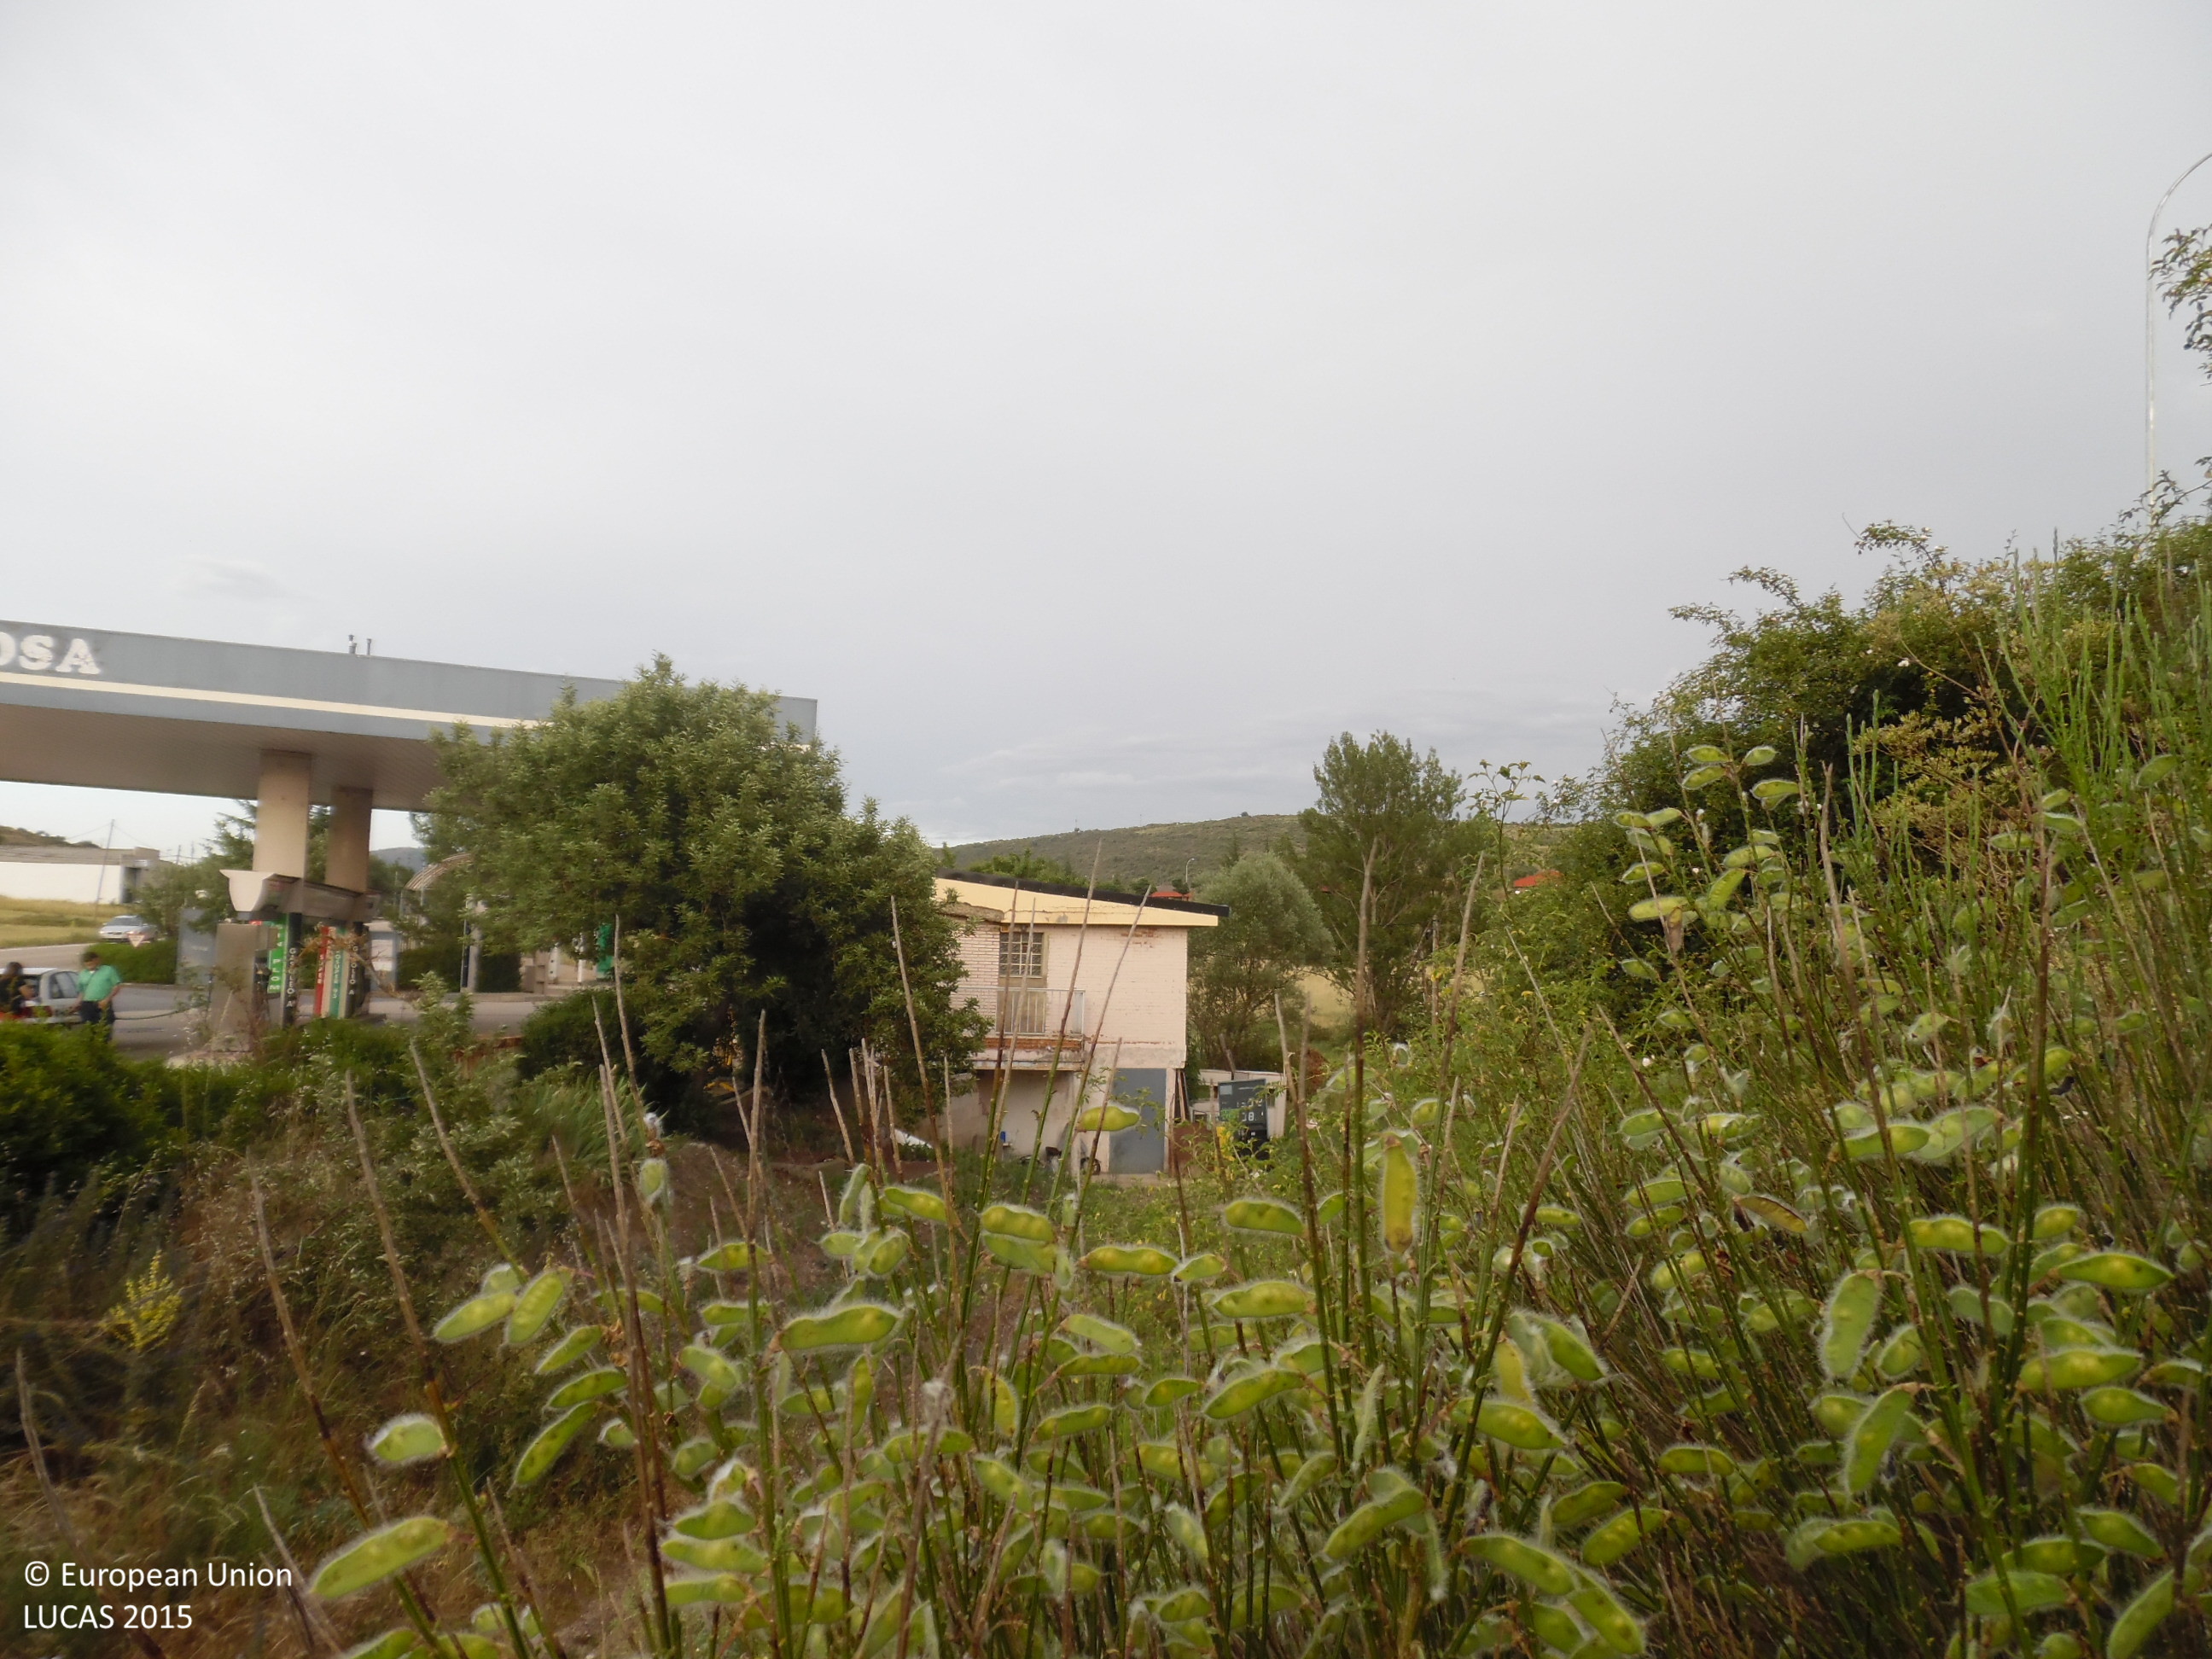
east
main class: Grassland
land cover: Grassland with sparse tree/shrub cover
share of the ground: 10 - 25 %
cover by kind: unconsolidated bare surface 70 %, herbaceous plants 25 %, broadleaved forest trees 5 %
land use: Road transport
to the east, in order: Grassland with sparse tree/shrub cover; Artificial constructions in urban areas; Grassland with sparse tree/shrub cover; Grass margins; Rivers and streams; Grassland with sparse tree/shrub cover; Grassland without tree/shrub cover; Lucerne; Grassland without tree/shrub cover
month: June
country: ES
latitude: 42.7841
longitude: -5.7875
